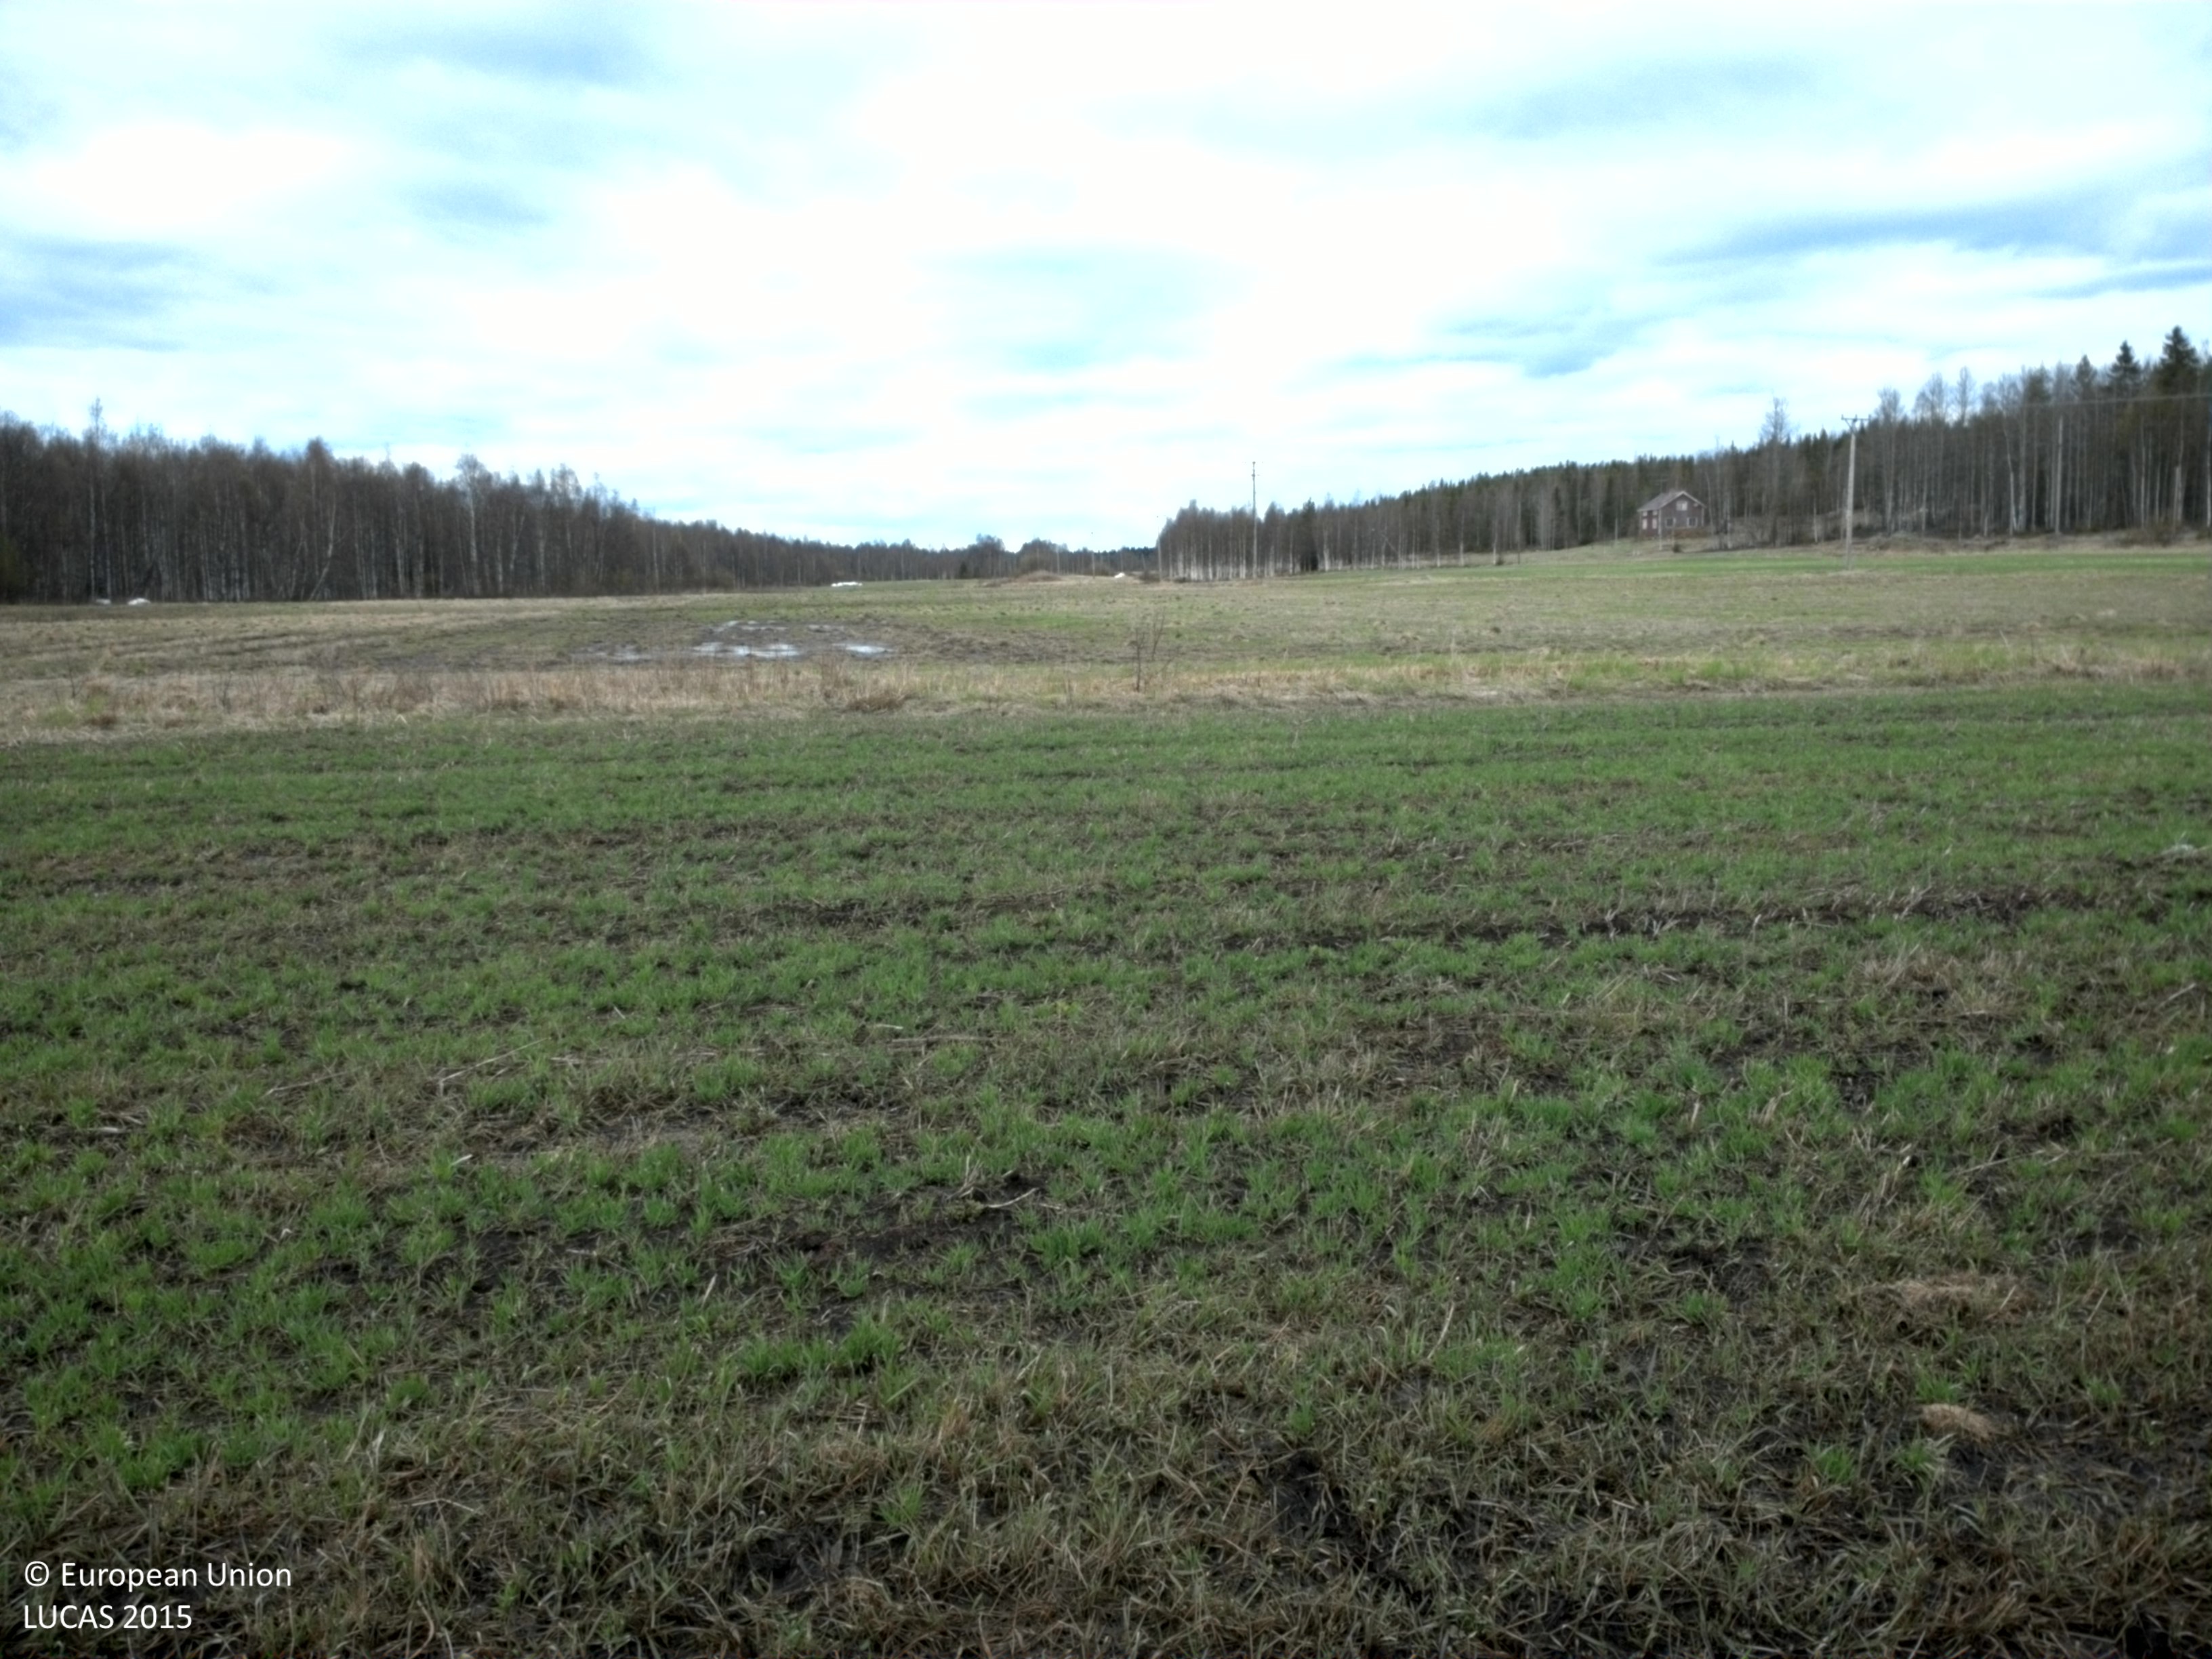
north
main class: Cropland
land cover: Temporary grasslands
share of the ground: > 75 %
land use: Agriculture (excluding fallow land and kitchen gardens)
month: May
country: SE
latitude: 65.9649
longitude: 23.7917
